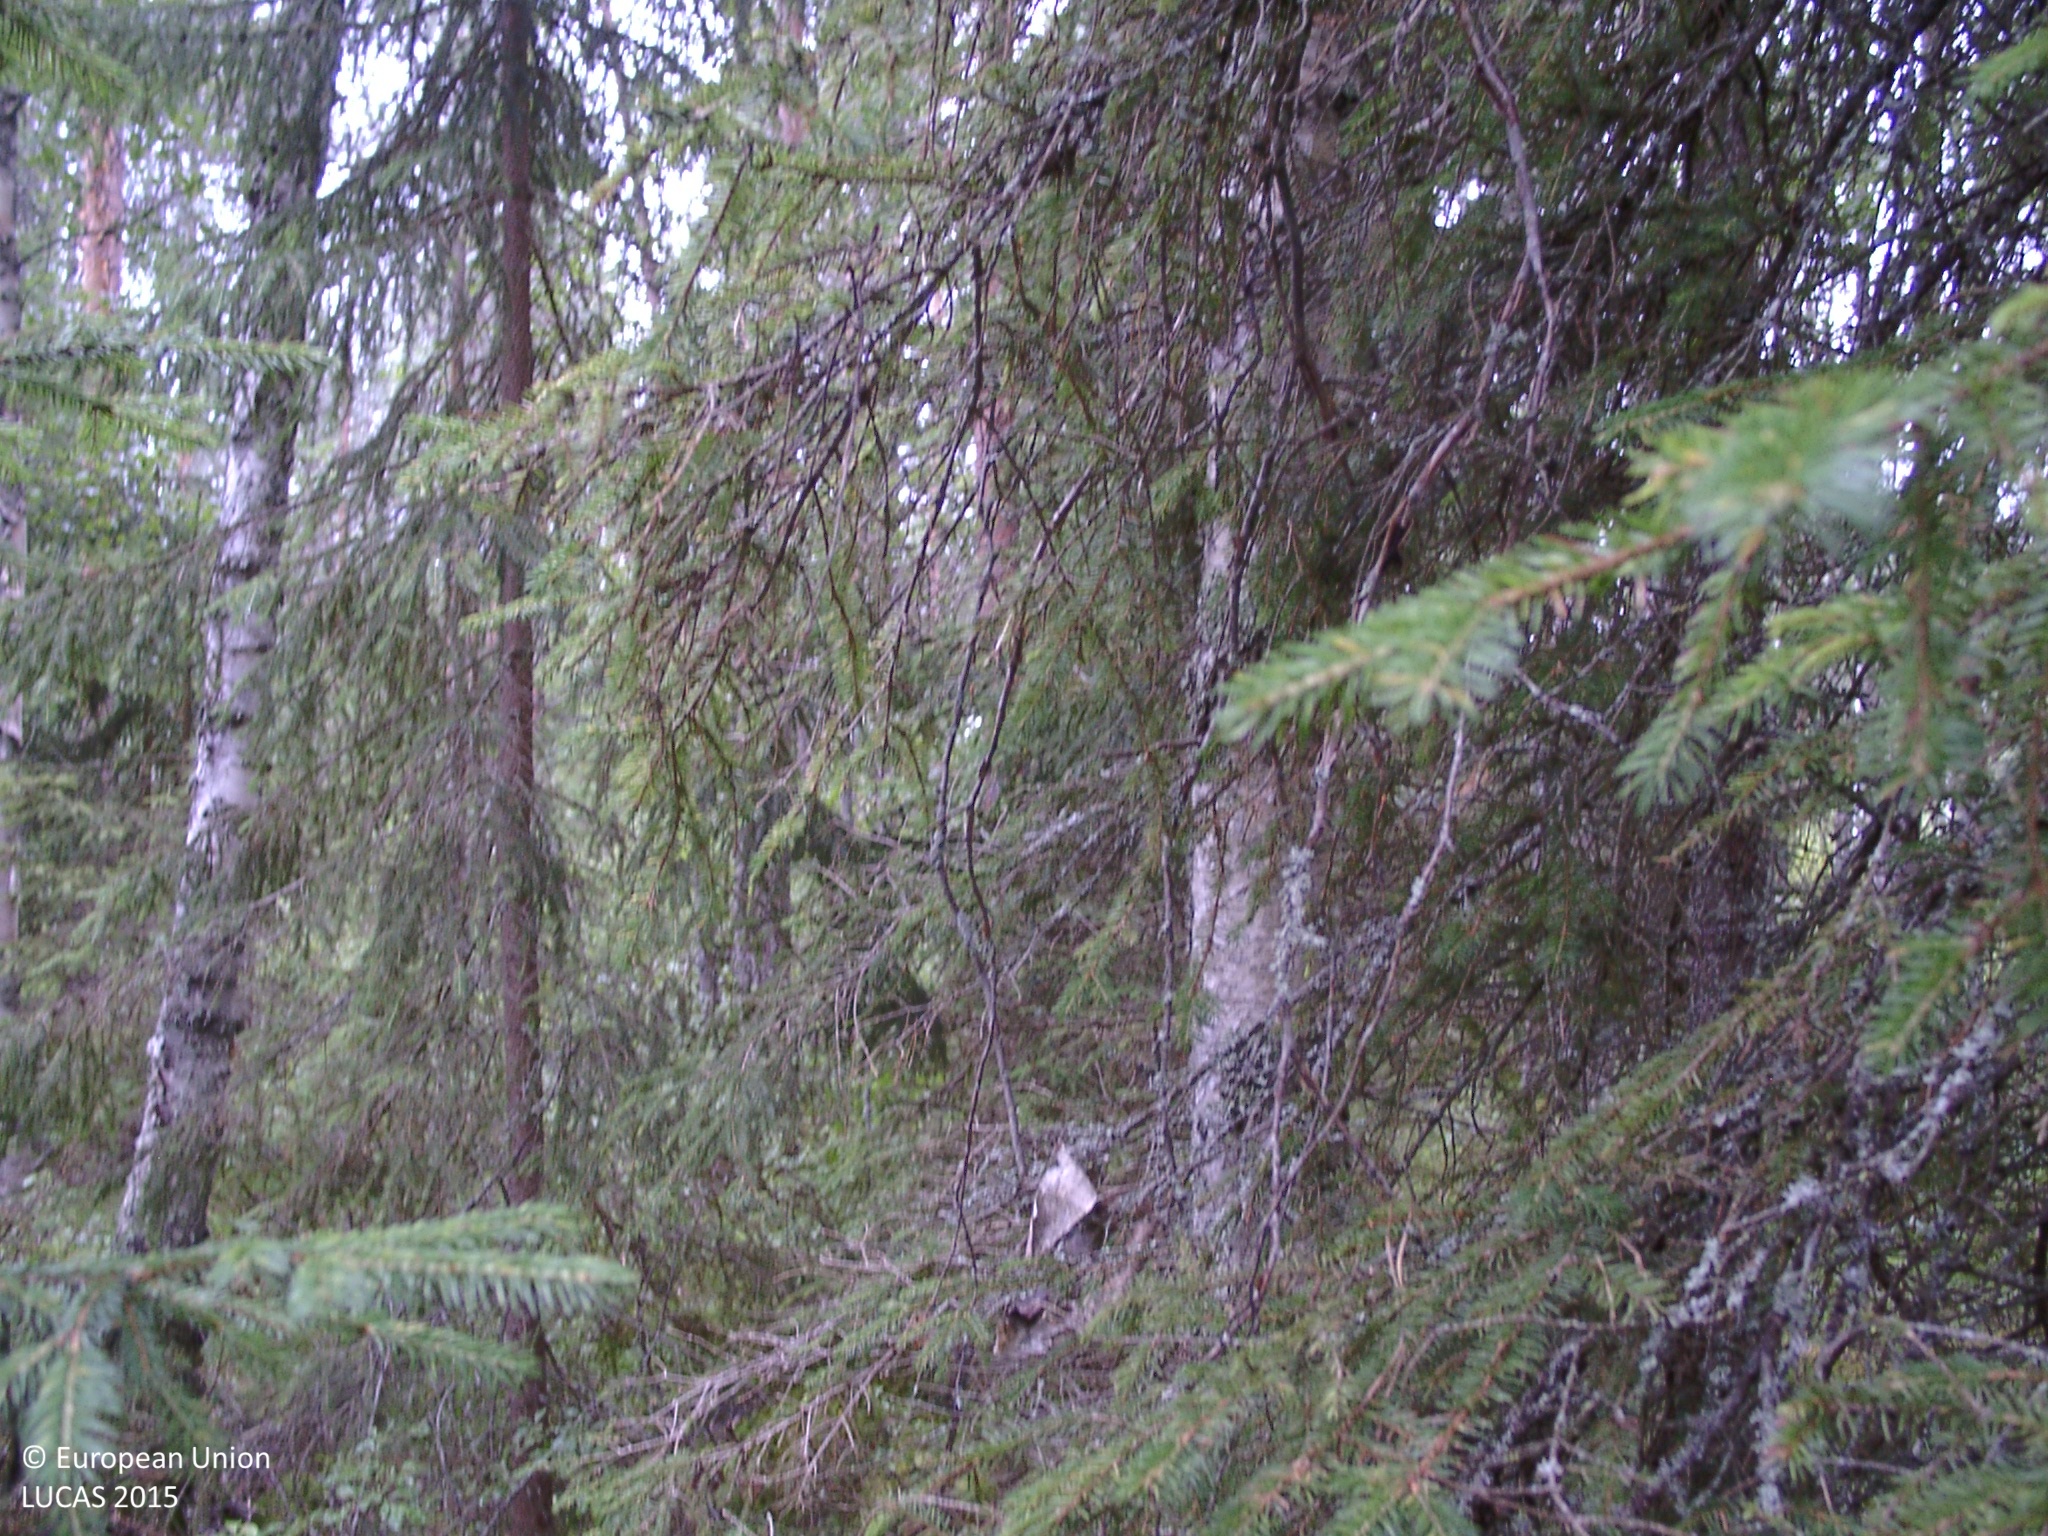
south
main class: Woodland
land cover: Other mixed woodland
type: boreal forest
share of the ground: 50 - 75 %
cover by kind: coniferous forest trees 35 %, broadleaved forest trees 30 %, shrubs 20 %, lichens and mosses 10 %, herbaceous plants 5 %
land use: Forestry
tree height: > 5 m
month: August
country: FI
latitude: 62.7813
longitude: 24.5709
